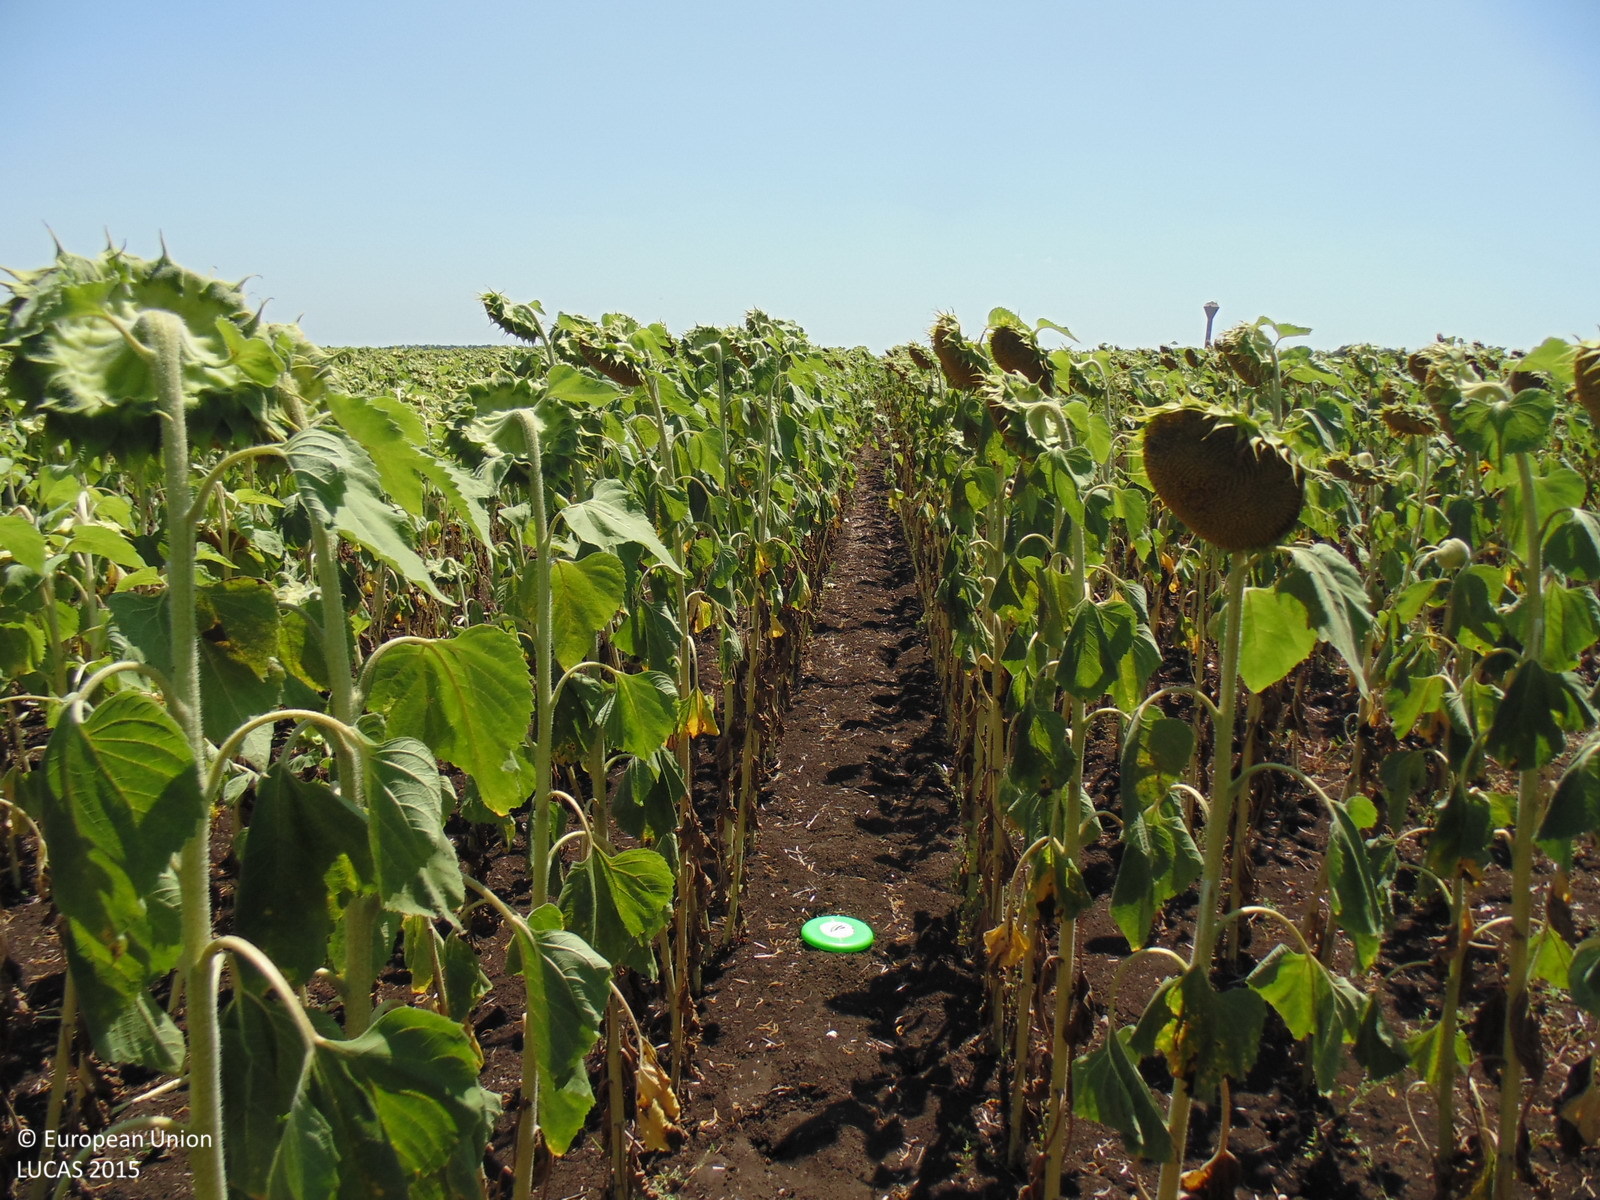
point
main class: Cropland
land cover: Sunflower
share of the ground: > 75 %
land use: Agriculture (excluding fallow land and kitchen gardens)
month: August
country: BG
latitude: 43.5045
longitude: 28.1716
